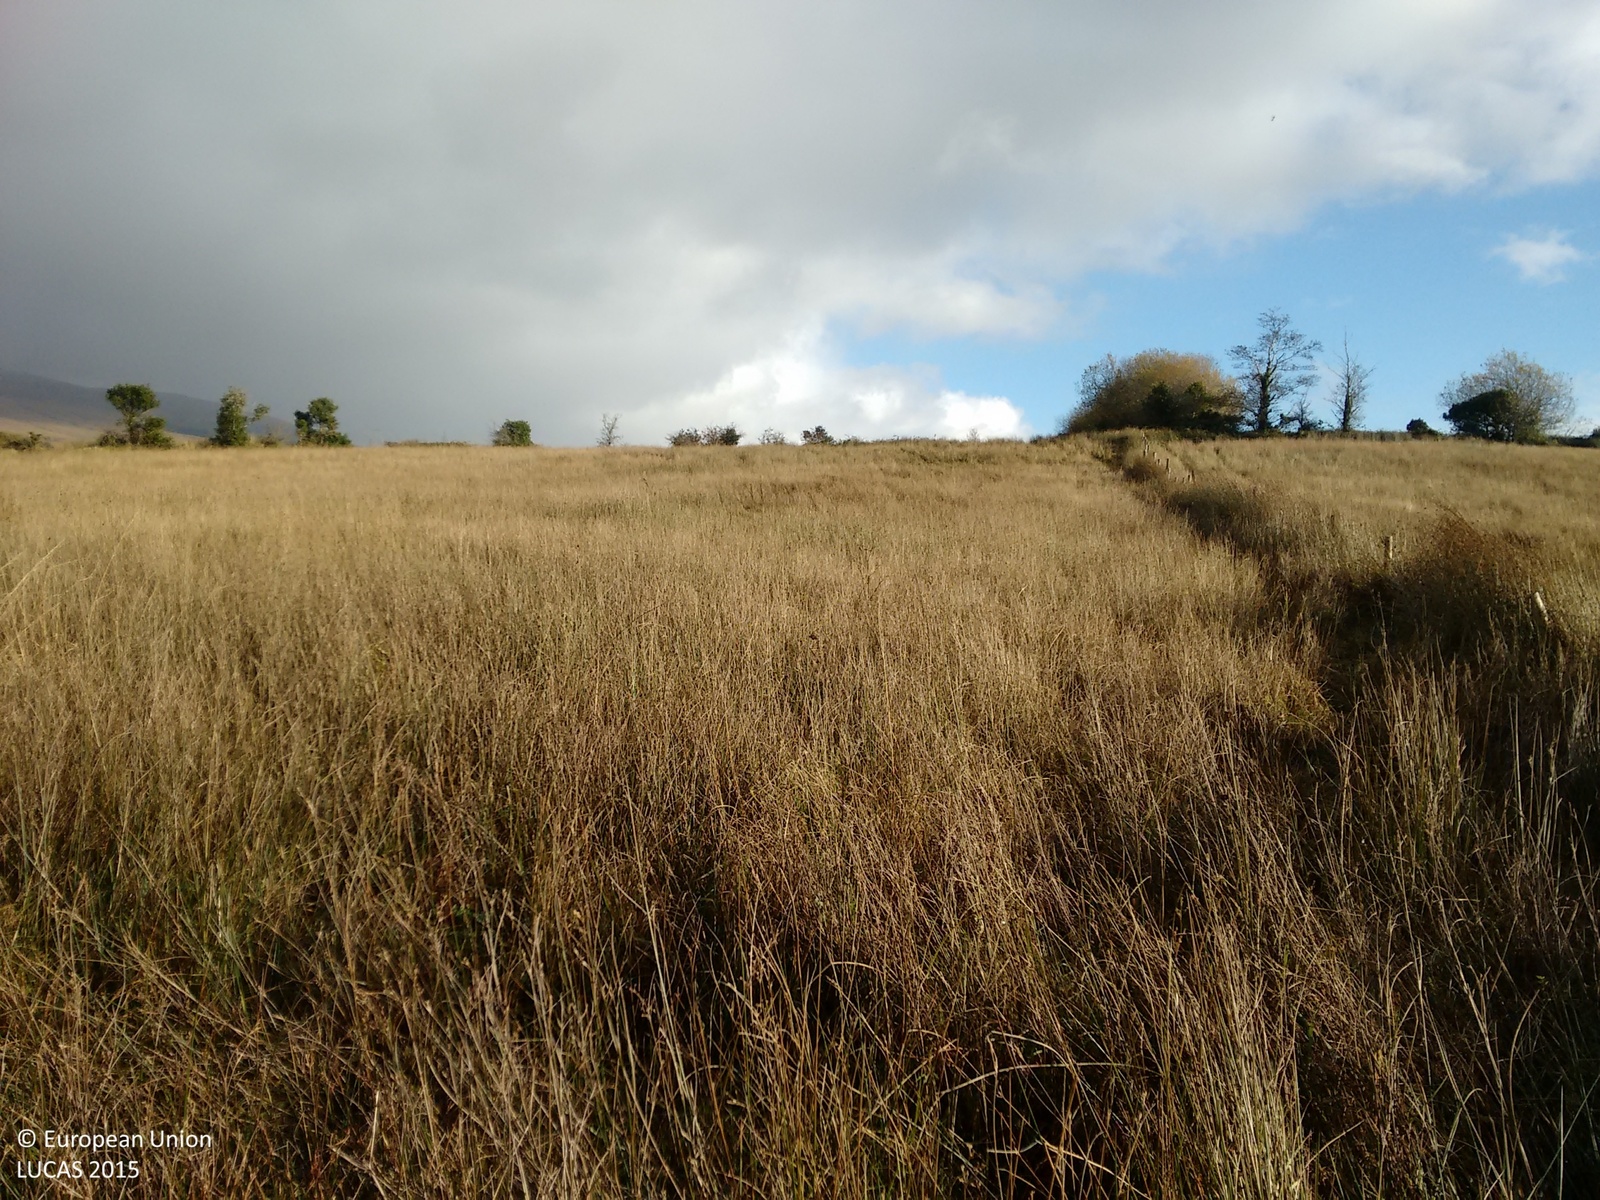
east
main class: Grassland
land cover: Grassland without tree/shrub cover
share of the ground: > 75 %
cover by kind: herbaceous plants 100 %
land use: Agriculture (excluding fallow land and kitchen gardens)
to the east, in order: Grassland without tree/shrub cover; Abandoned hedges; Grassland without tree/shrub cover; Abandoned hedges; Grassland without tree/shrub cover; Ditches and canals; Abandoned hedges
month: November
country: IE
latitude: 54.0615
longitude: -8.0355
